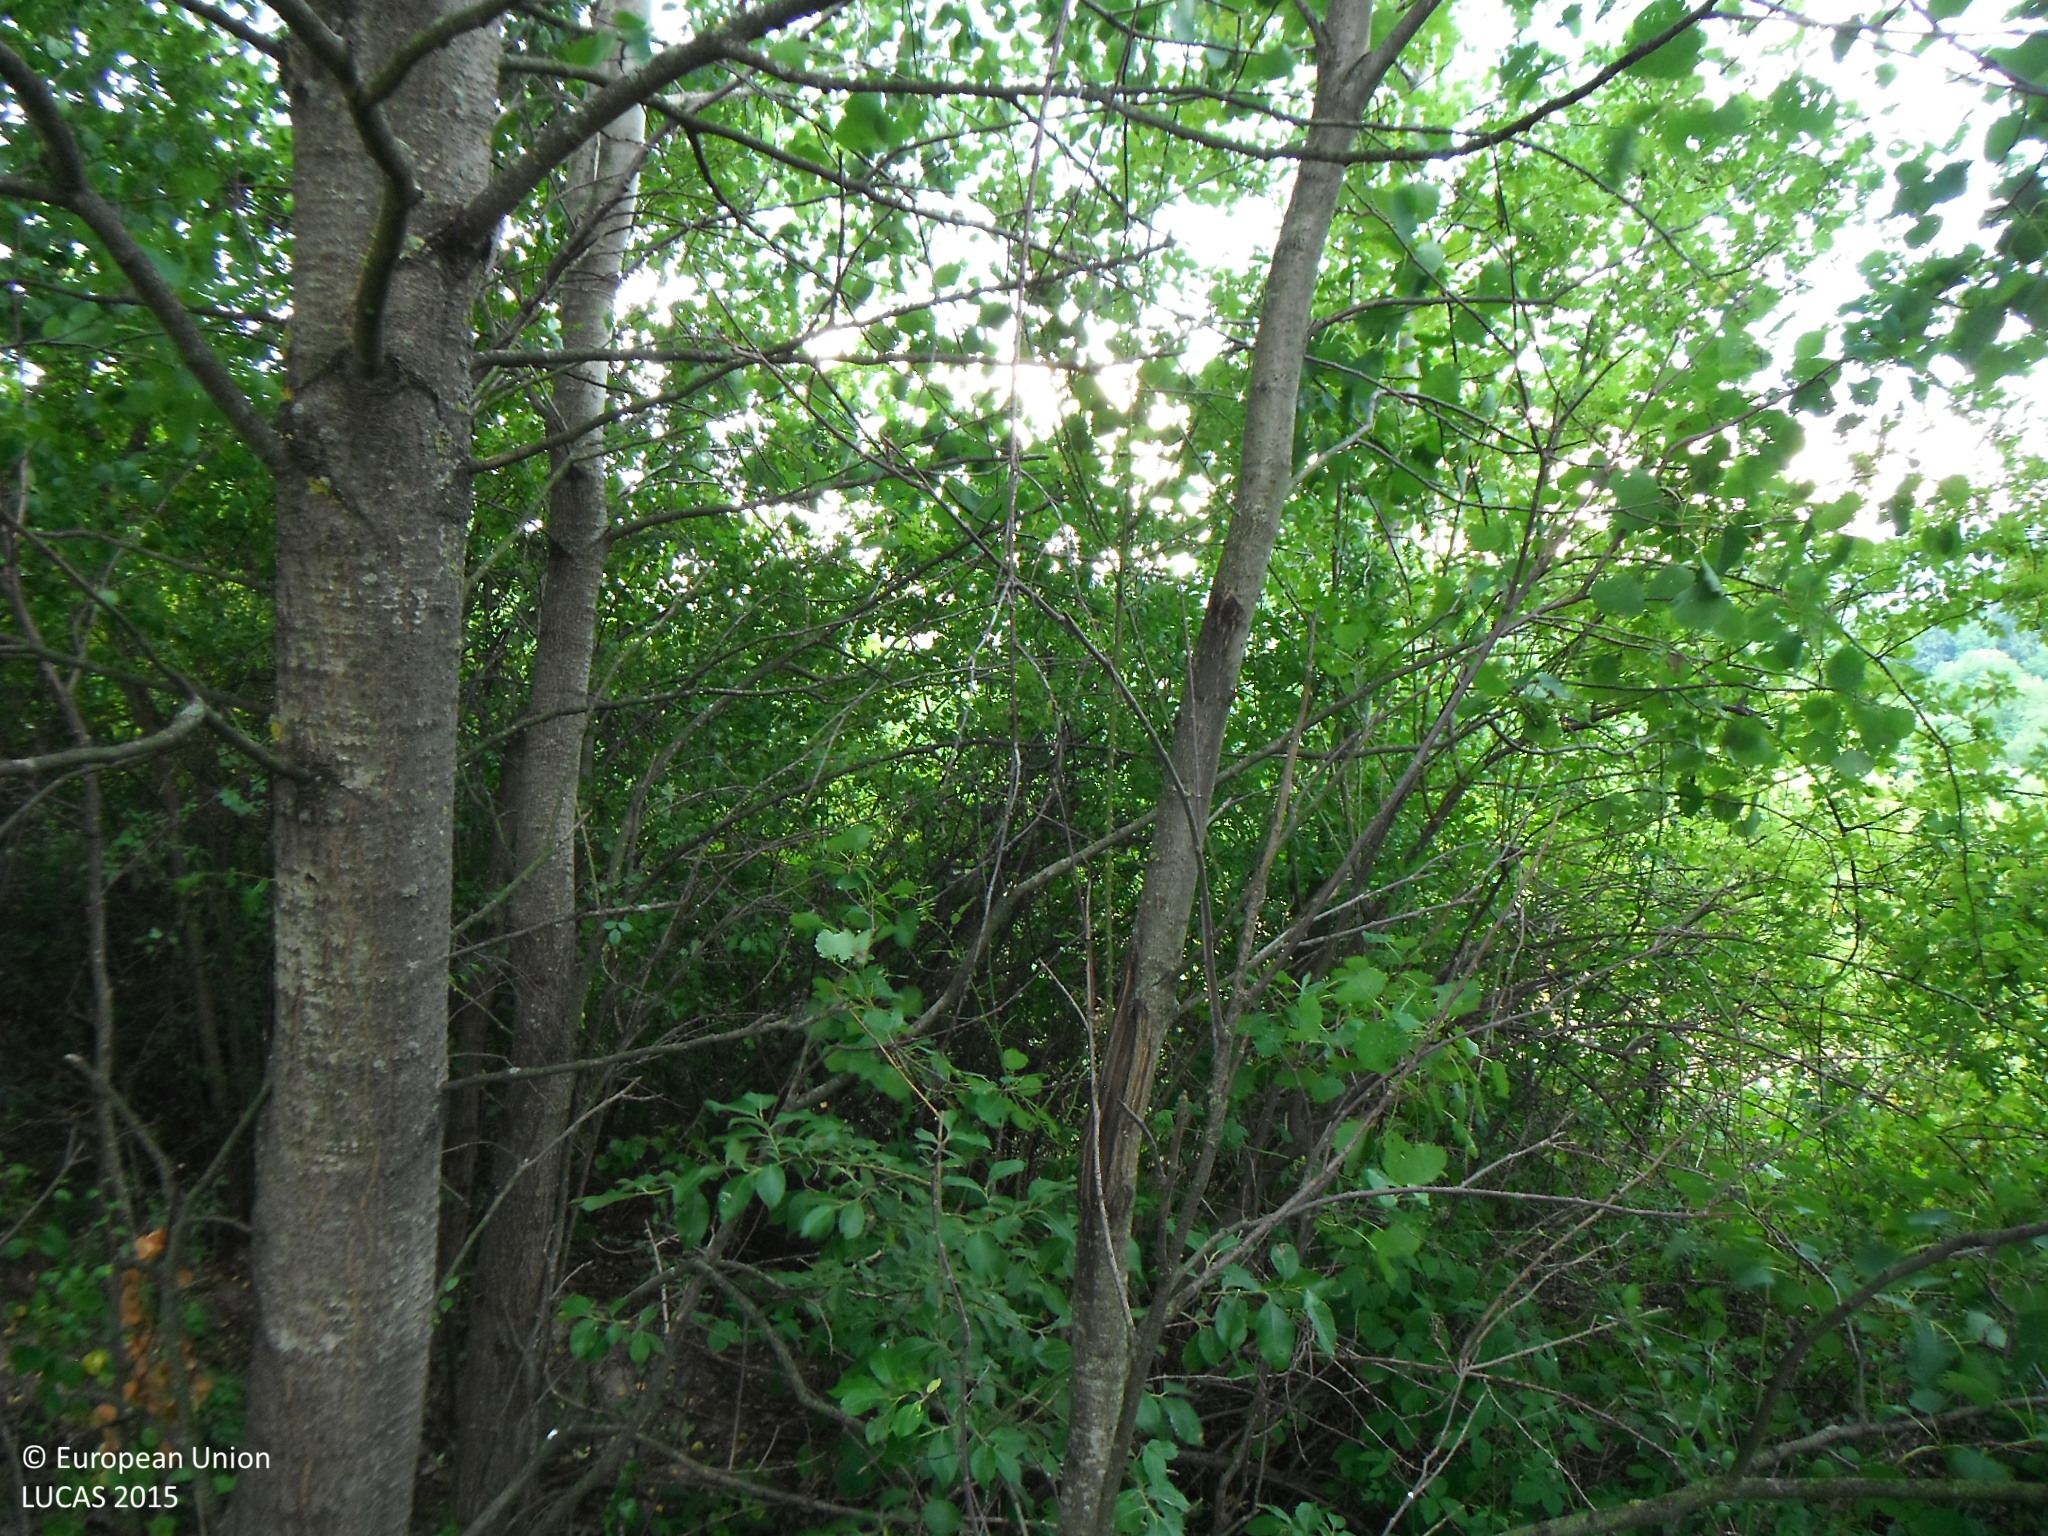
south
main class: Woodland
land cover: Broadleaved woodland
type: beech forest
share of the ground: > 75 %
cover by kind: broadleaved forest trees 100 %
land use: Forestry
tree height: > 5 m
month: July
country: SK
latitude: 49.3273
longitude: 21.6783
